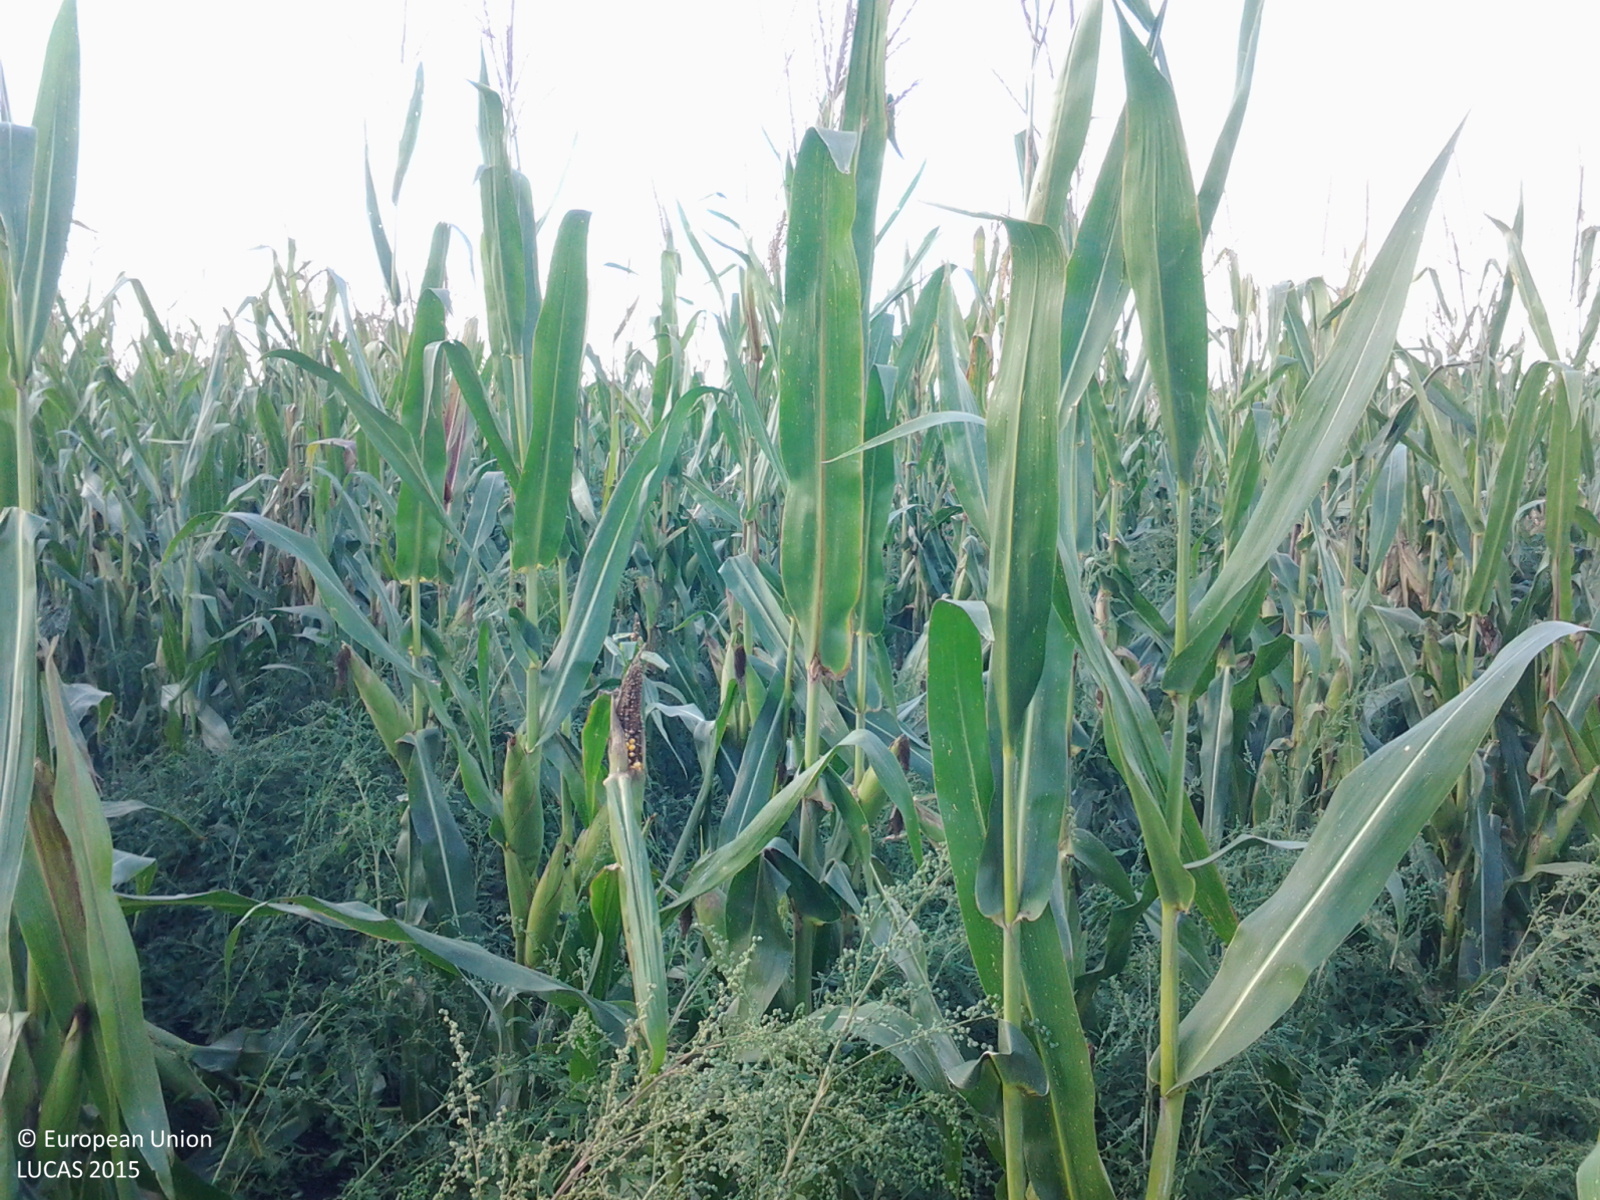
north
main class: Cropland
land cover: Maize
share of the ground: > 75 %
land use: Agriculture (excluding fallow land and kitchen gardens)
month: September
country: HU
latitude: 47.5632
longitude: 20.2496
